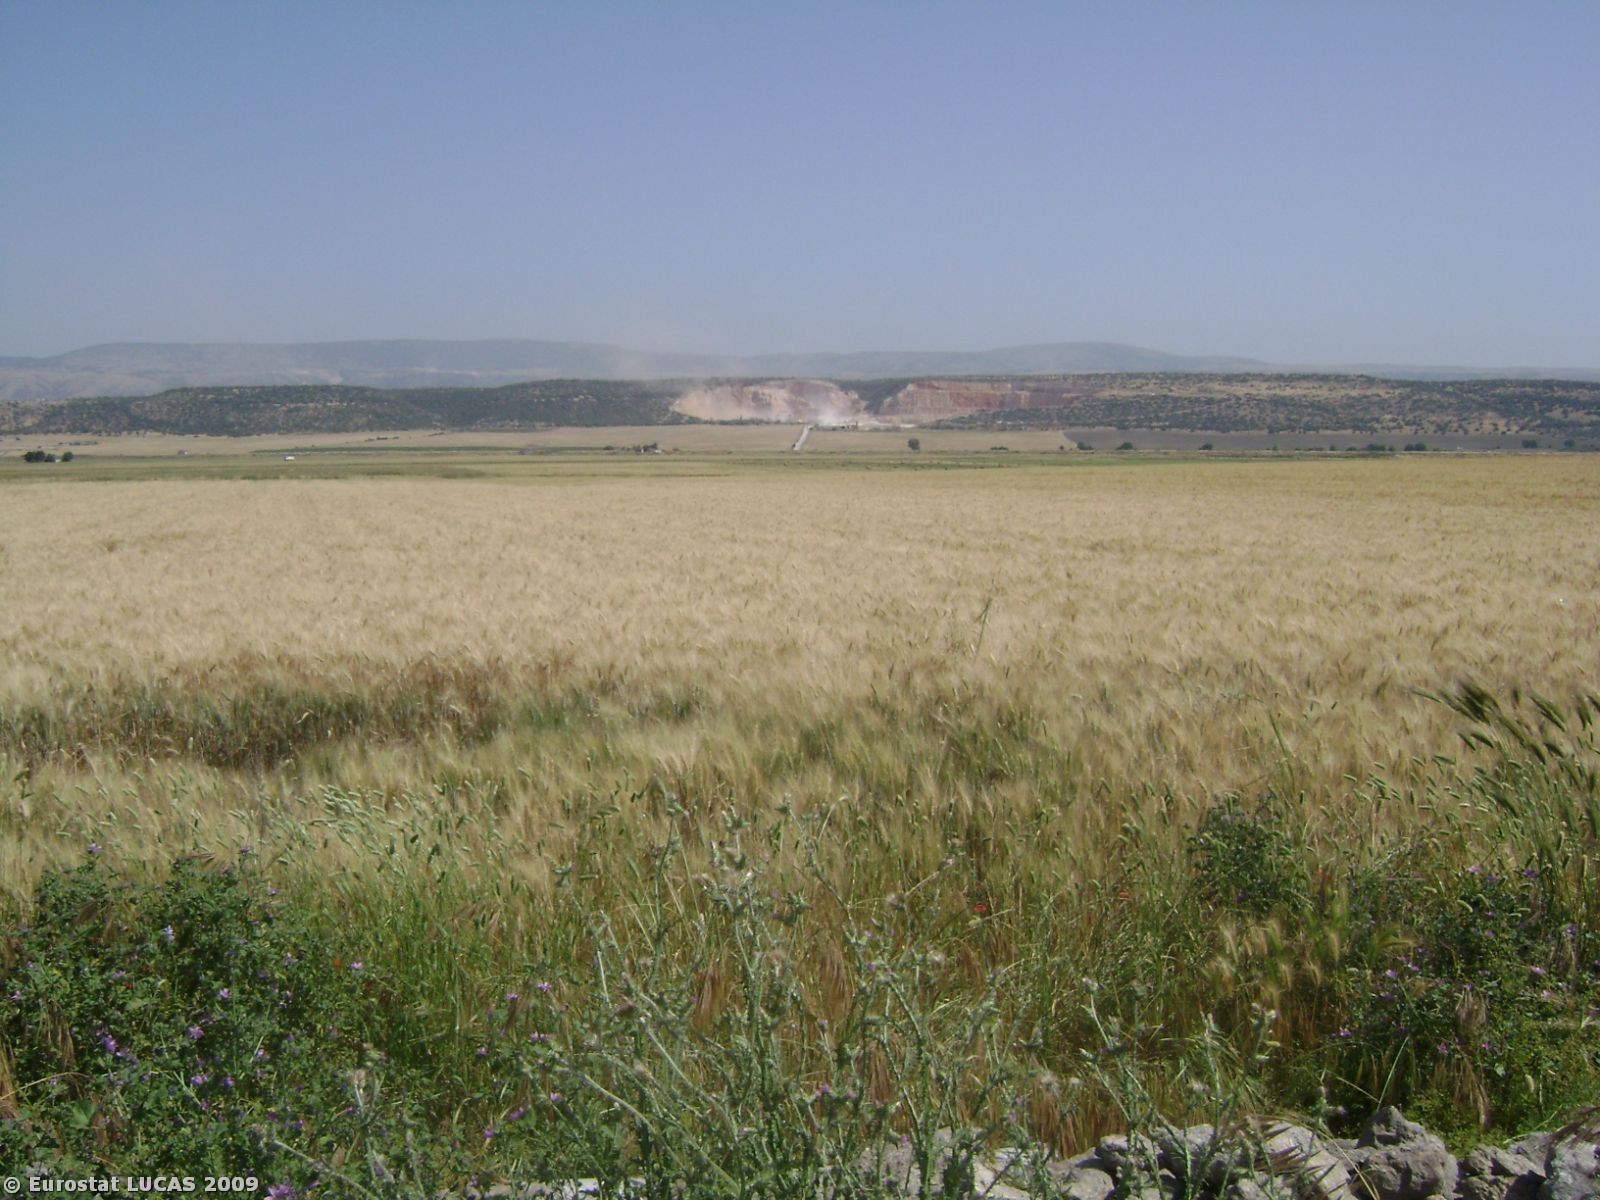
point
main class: Cropland
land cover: Durum wheat
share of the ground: > 75 %
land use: Agriculture (excluding fallow land and kitchen gardens)
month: May
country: IT
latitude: 41.5878
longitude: 15.7042
